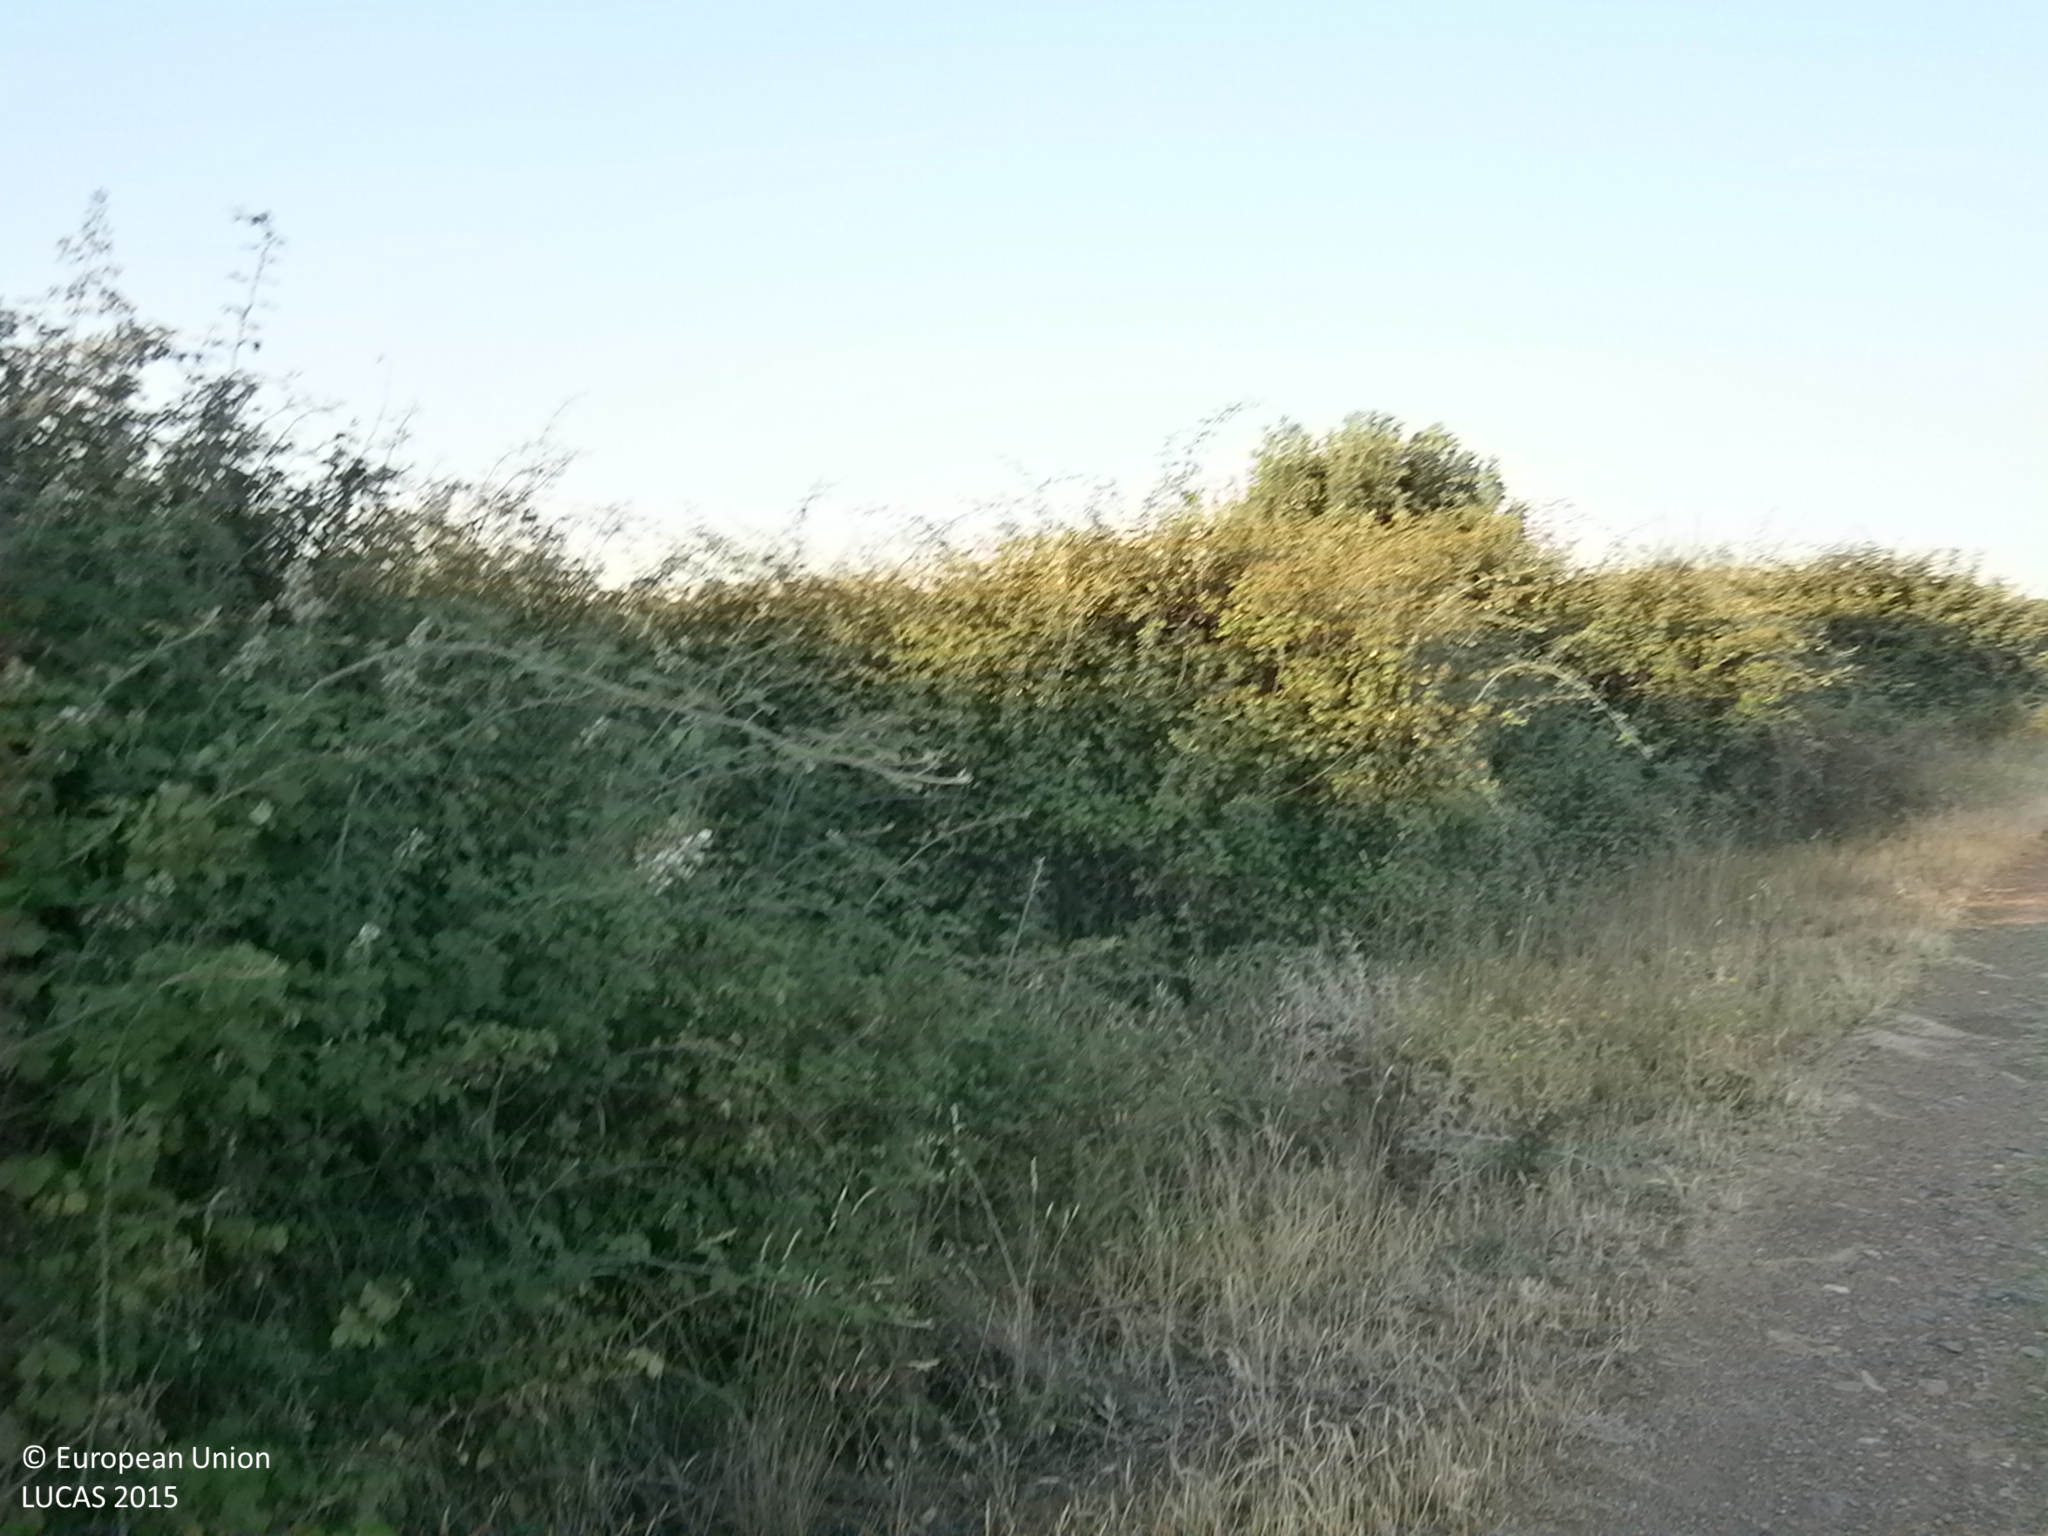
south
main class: Grassland
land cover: Spontaneously vegetated surfaces
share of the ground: > 75 %
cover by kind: herbaceous plants 95 %, unconsolidated bare surface 5 %
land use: Abandoned areas
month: June
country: ES
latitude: 38.6447
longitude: -6.7786
